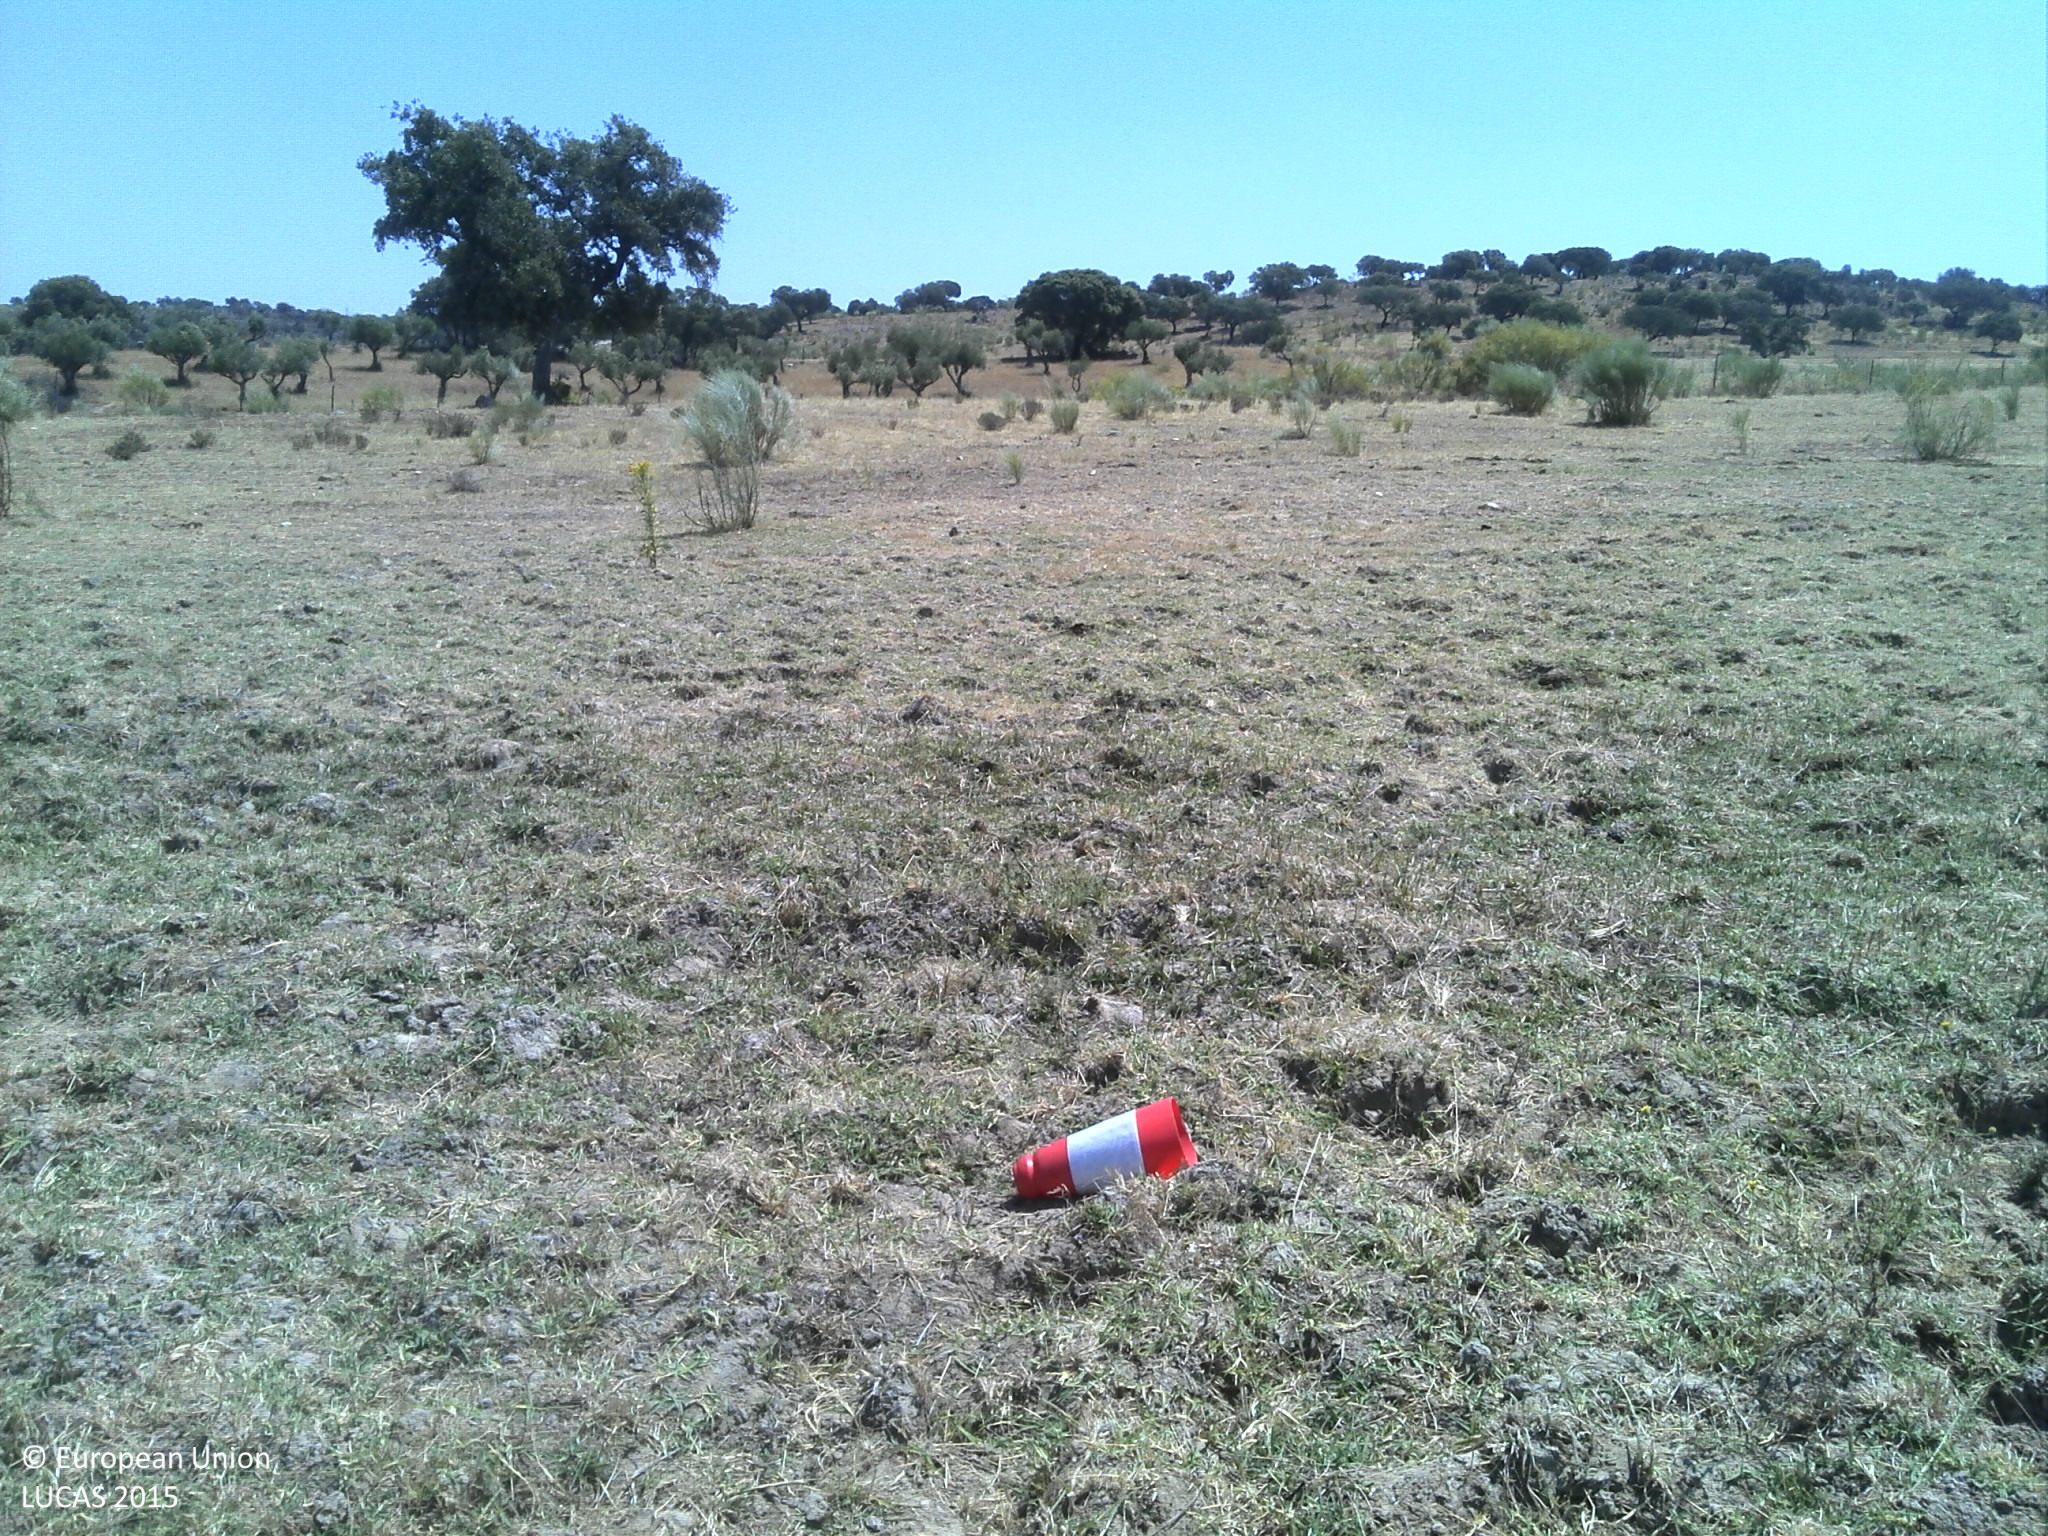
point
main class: Grassland
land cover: Grassland without tree/shrub cover
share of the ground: 10 - 25 %
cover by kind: unconsolidated bare surface 65 %, herbaceous plants 25 %, shrubs 5 %
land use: Agriculture (excluding fallow land and kitchen gardens)
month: June
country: PT
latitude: 39.7737
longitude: -7.1708
